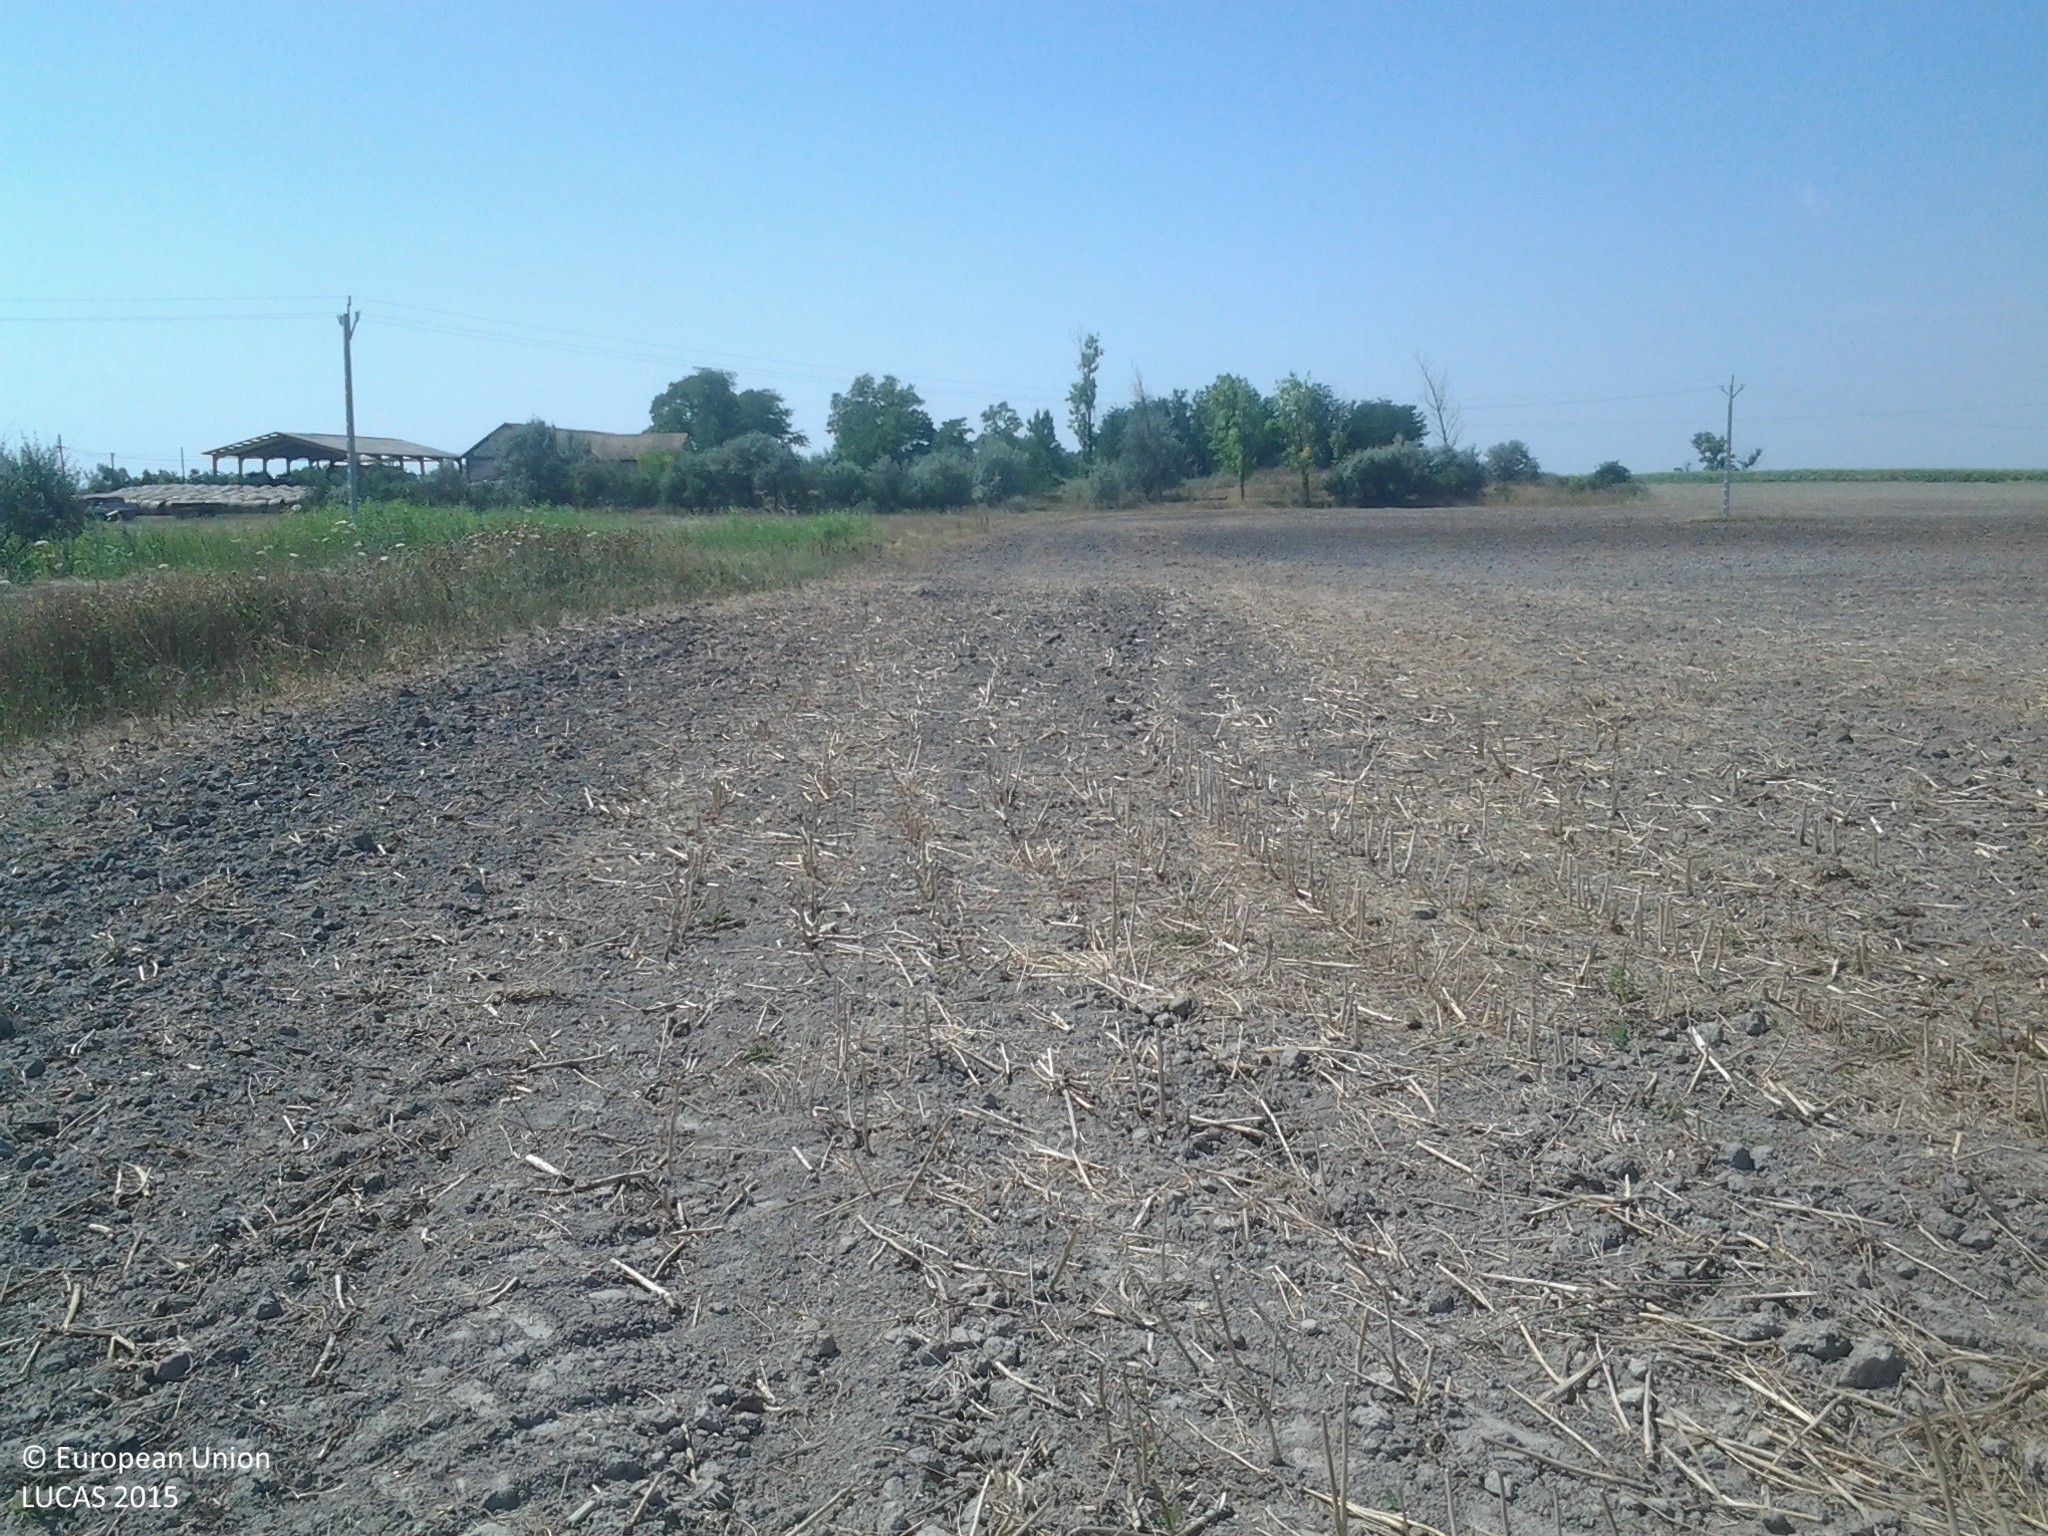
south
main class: Cropland
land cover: Rape and turnip rape
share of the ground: < 10 %
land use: Agriculture (excluding fallow land and kitchen gardens)
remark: Harvested field
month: July
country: HU
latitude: 46.6715
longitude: 19.0733
